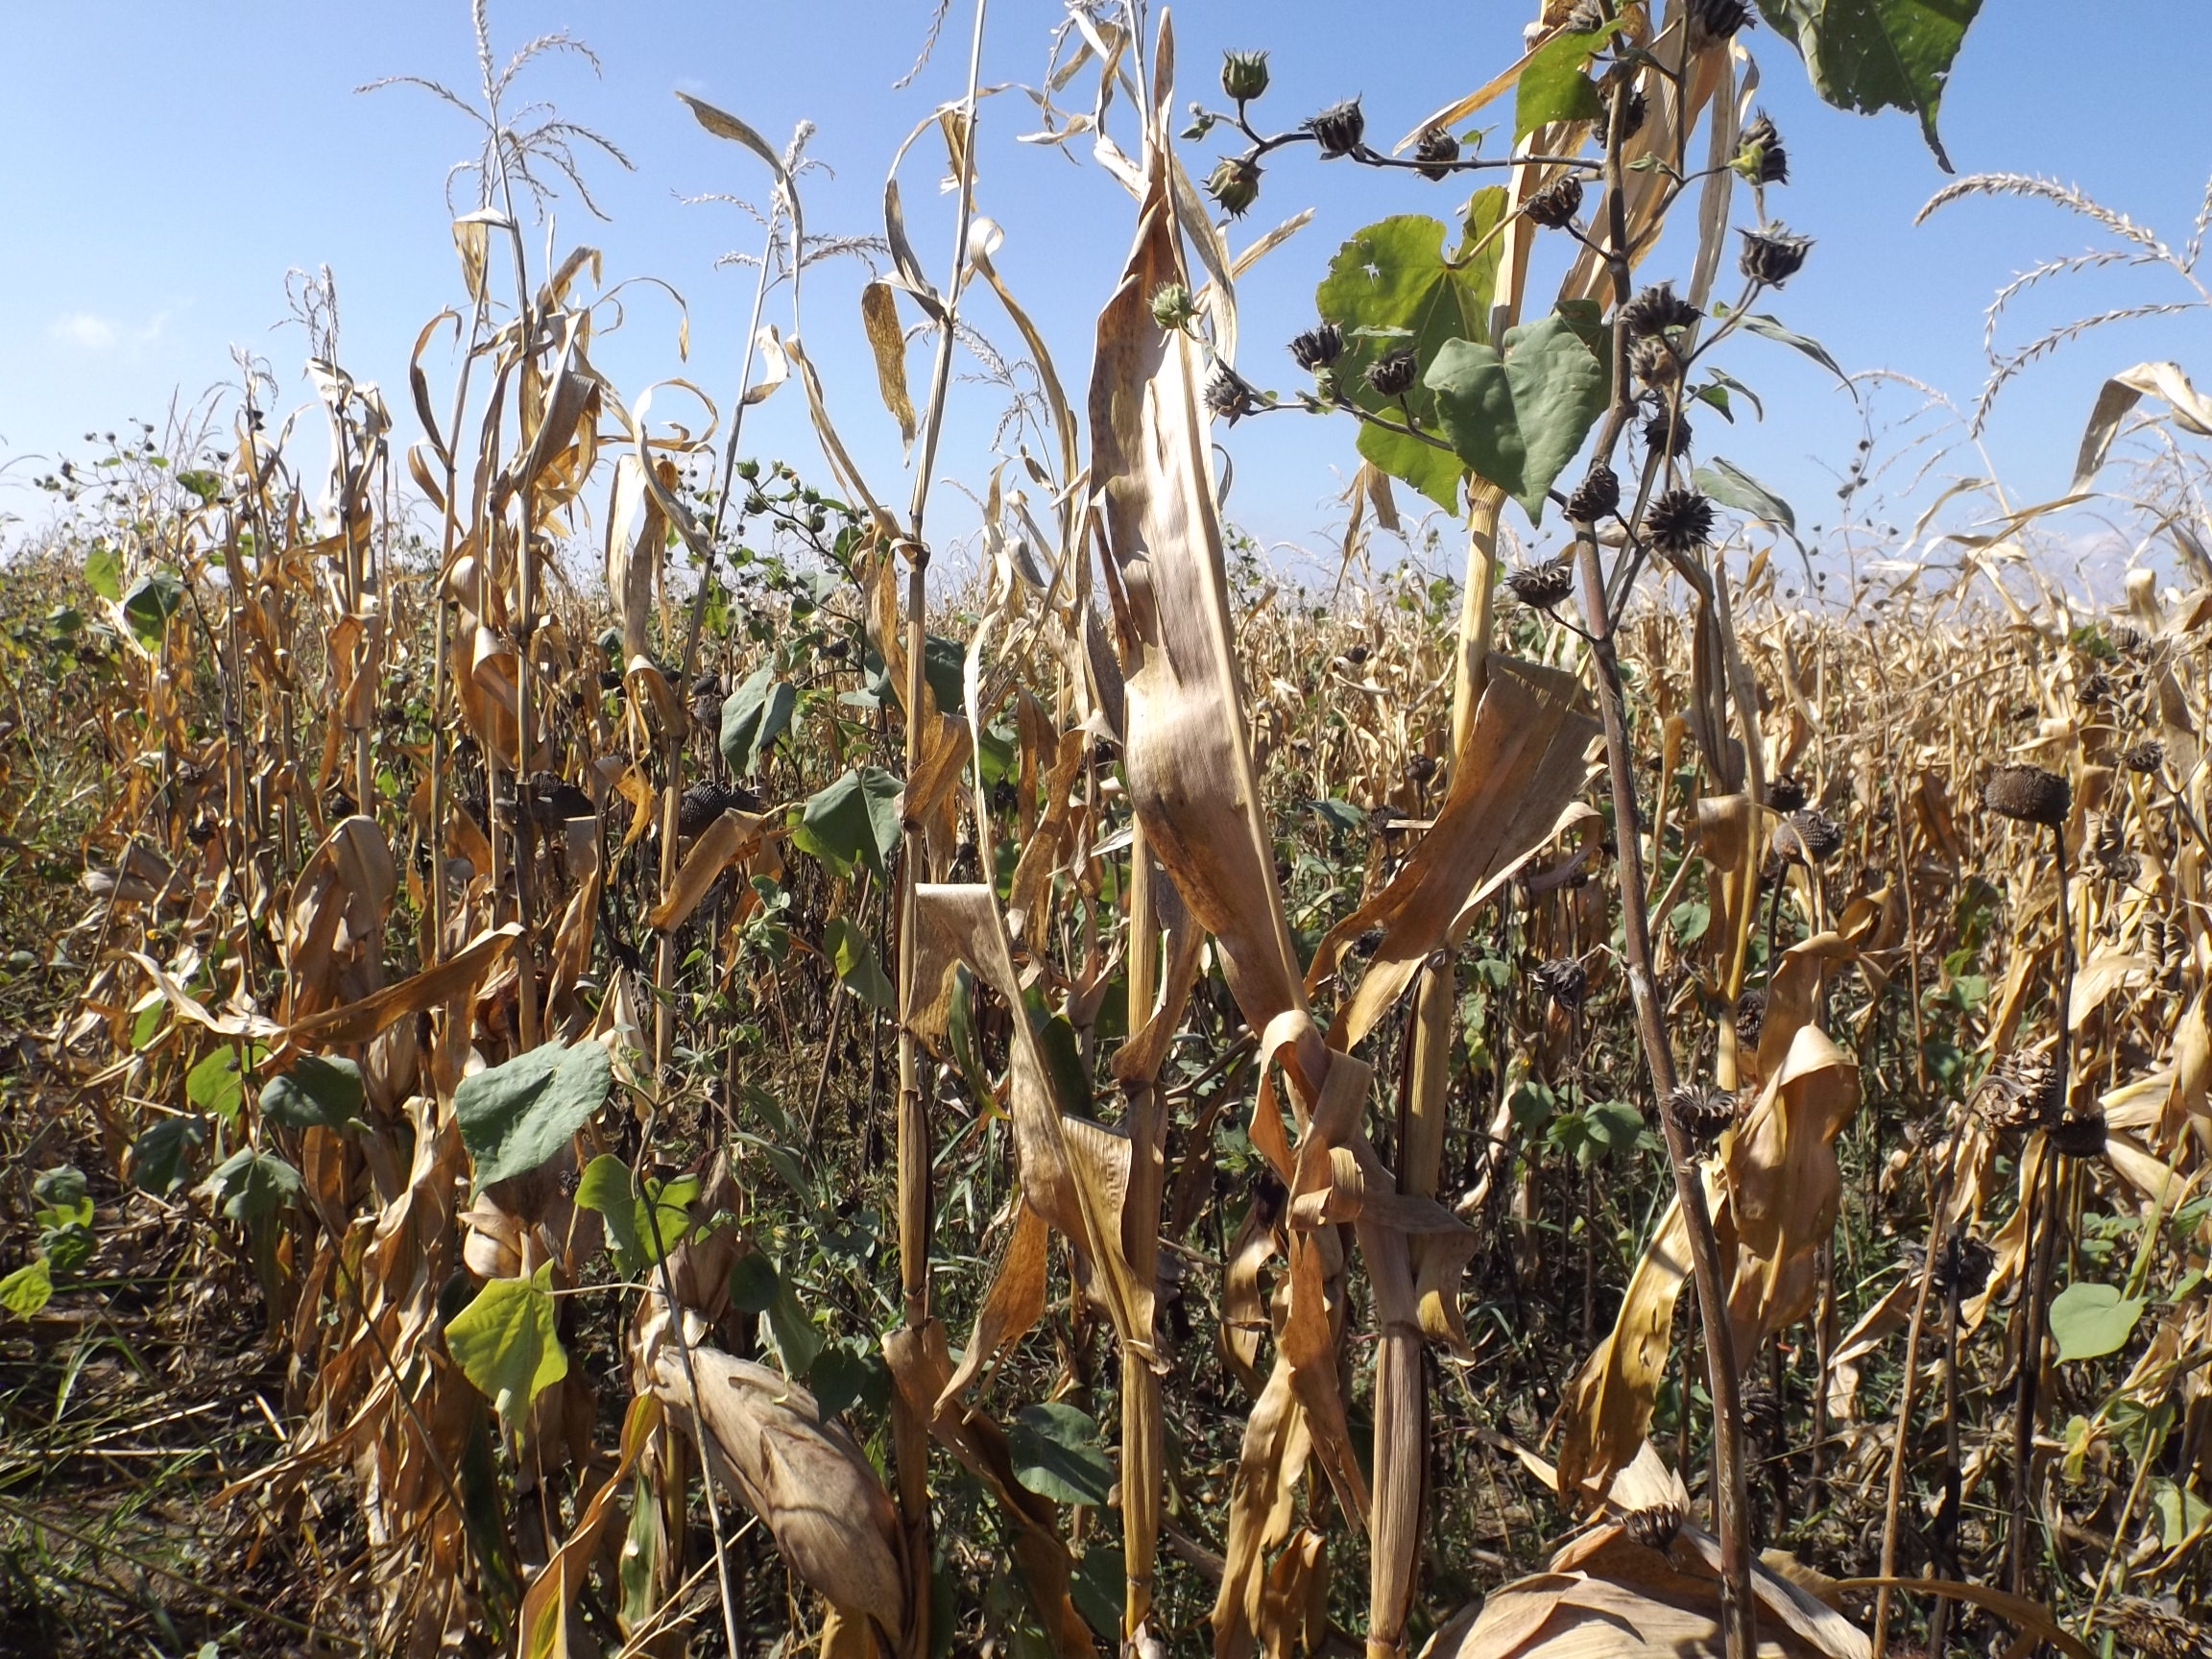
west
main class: Cropland
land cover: Maize
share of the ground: > 75 %
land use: Agriculture (excluding fallow land and kitchen gardens)
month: September
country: BG
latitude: 43.9389
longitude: 26.4918
